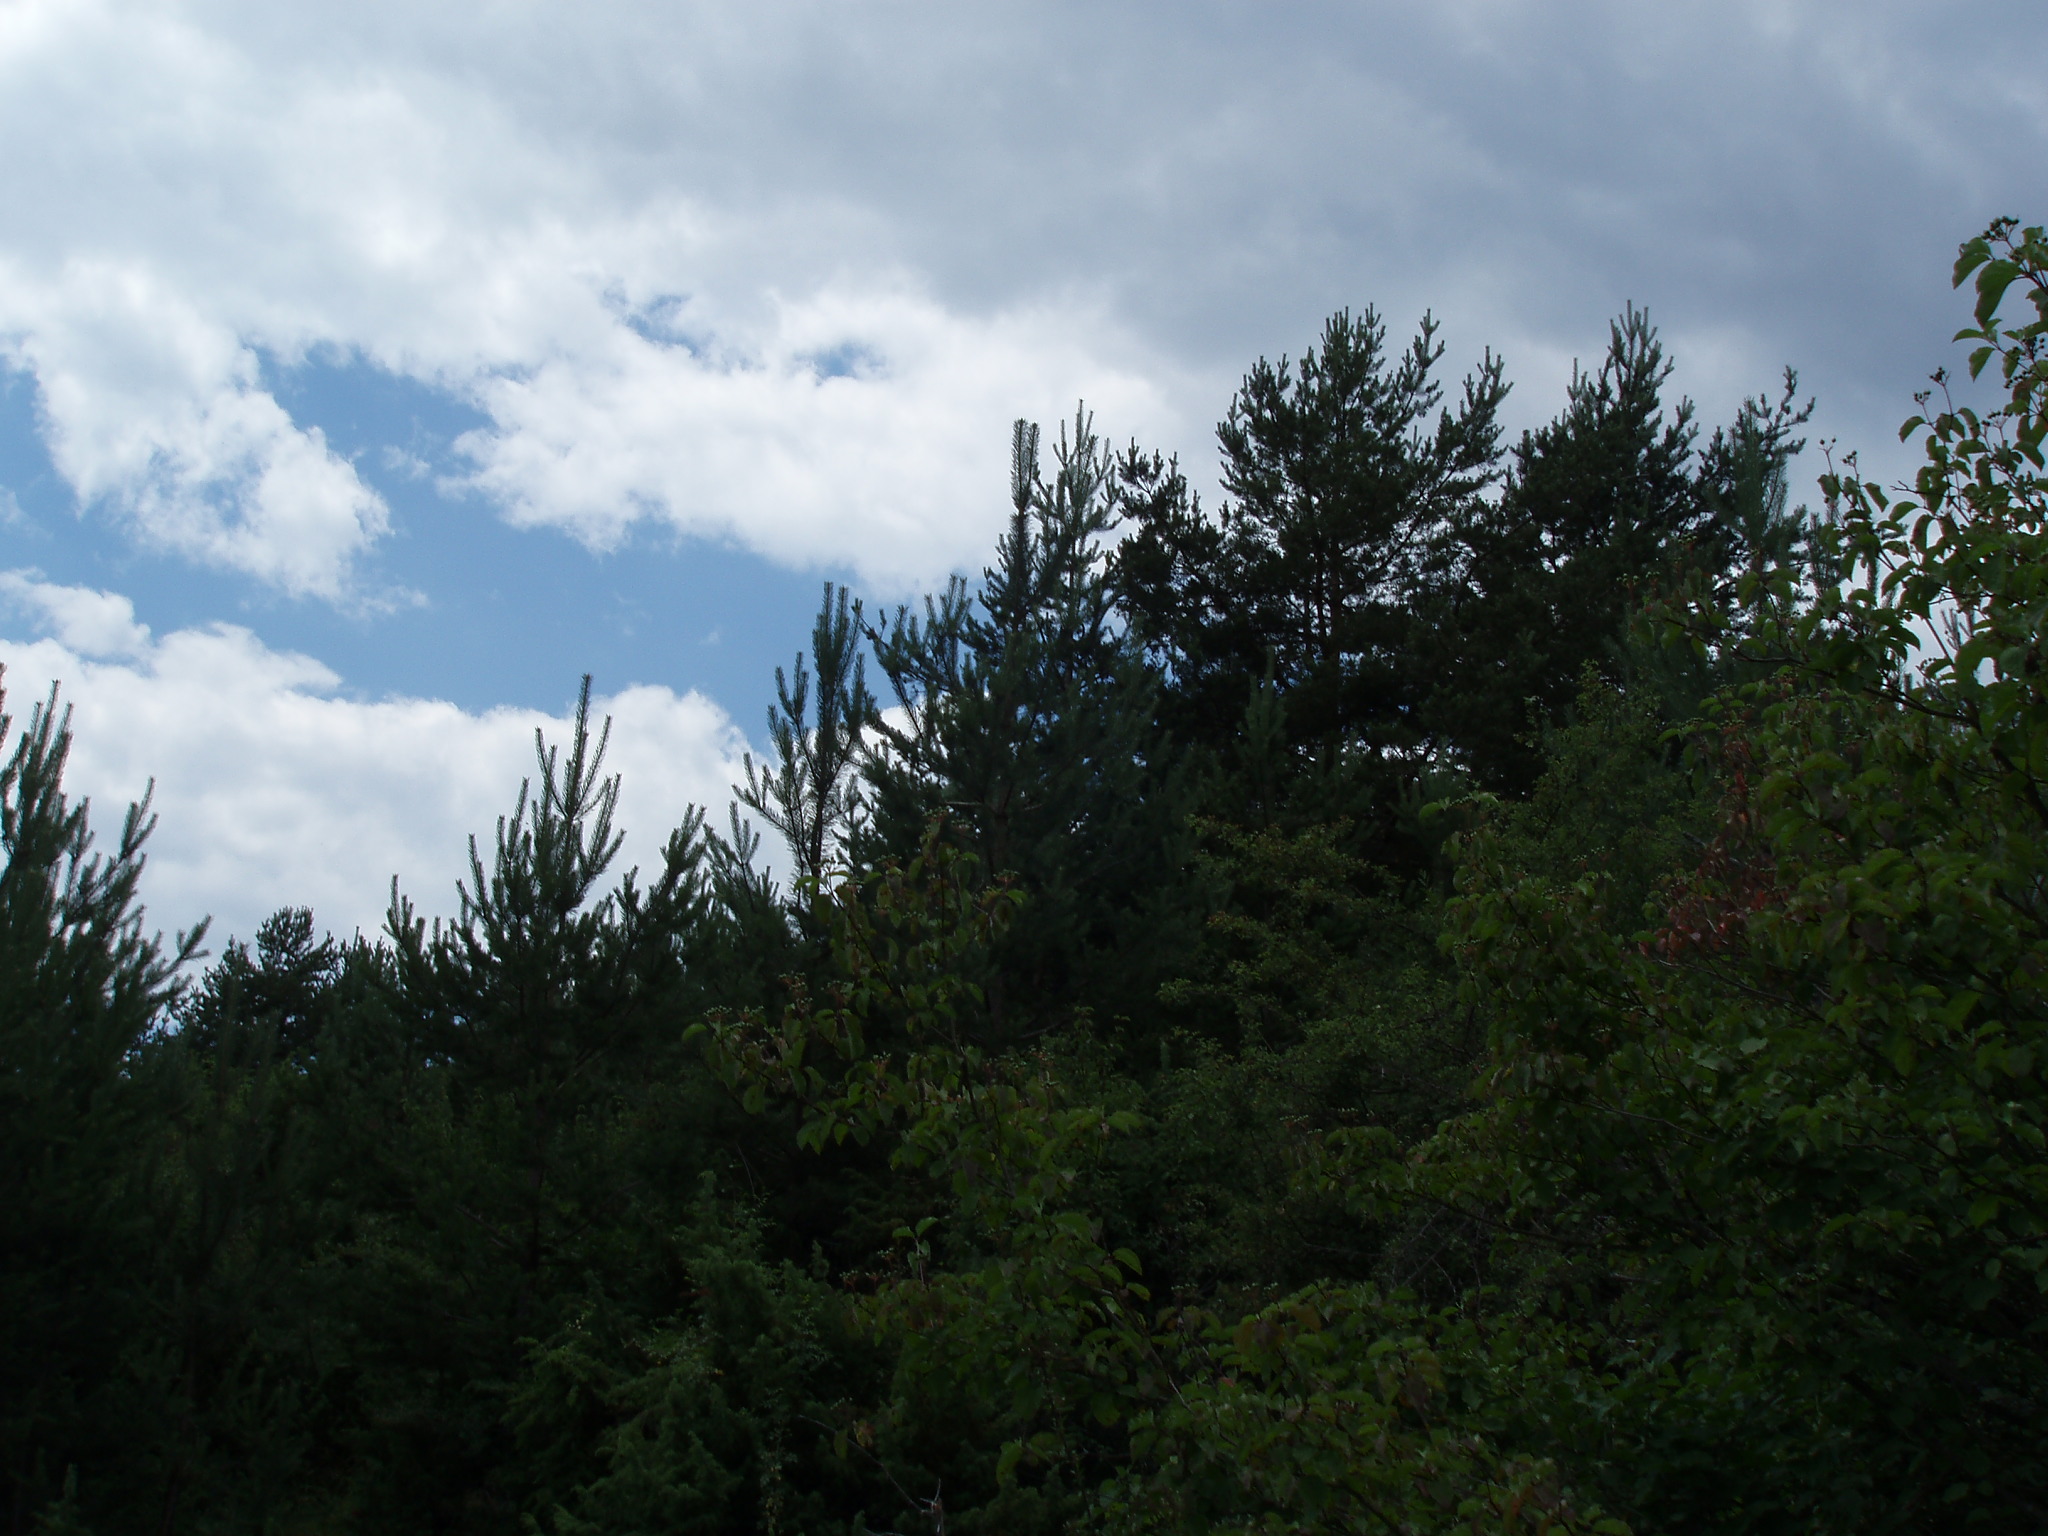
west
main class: Grassland
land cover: Grassland with sparse tree/shrub cover
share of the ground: > 75 %
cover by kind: herbaceous plants 90 %, broadleaved forest trees 5 %, shrubs 5 %
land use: Agriculture (excluding fallow land and kitchen gardens)
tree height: > 5 m
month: July
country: BG
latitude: 41.9108
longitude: 23.4951
